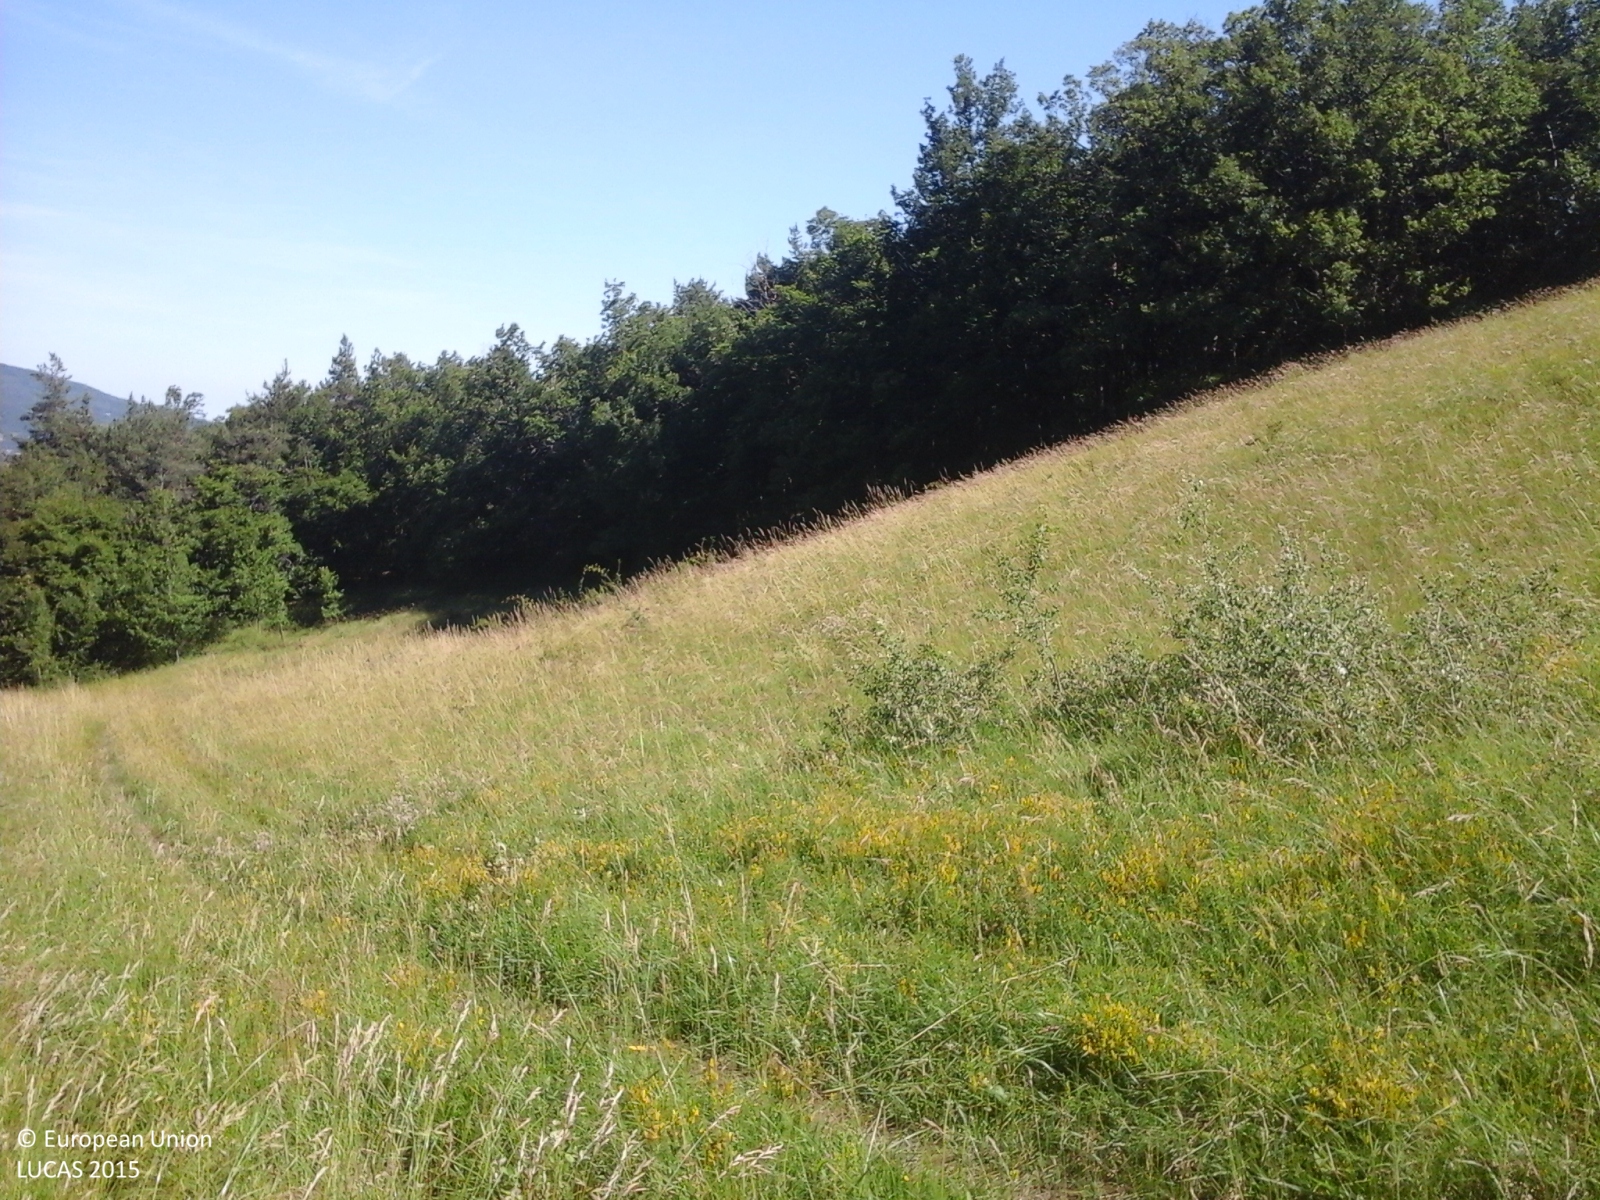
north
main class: Woodland
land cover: Broadleaved woodland
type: thermophilous deciduous forest
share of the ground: > 75 %
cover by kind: broadleaved forest trees 100 %
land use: Forestry
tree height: > 5 m
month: June
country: IT
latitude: 44.5127
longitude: 10.1883
